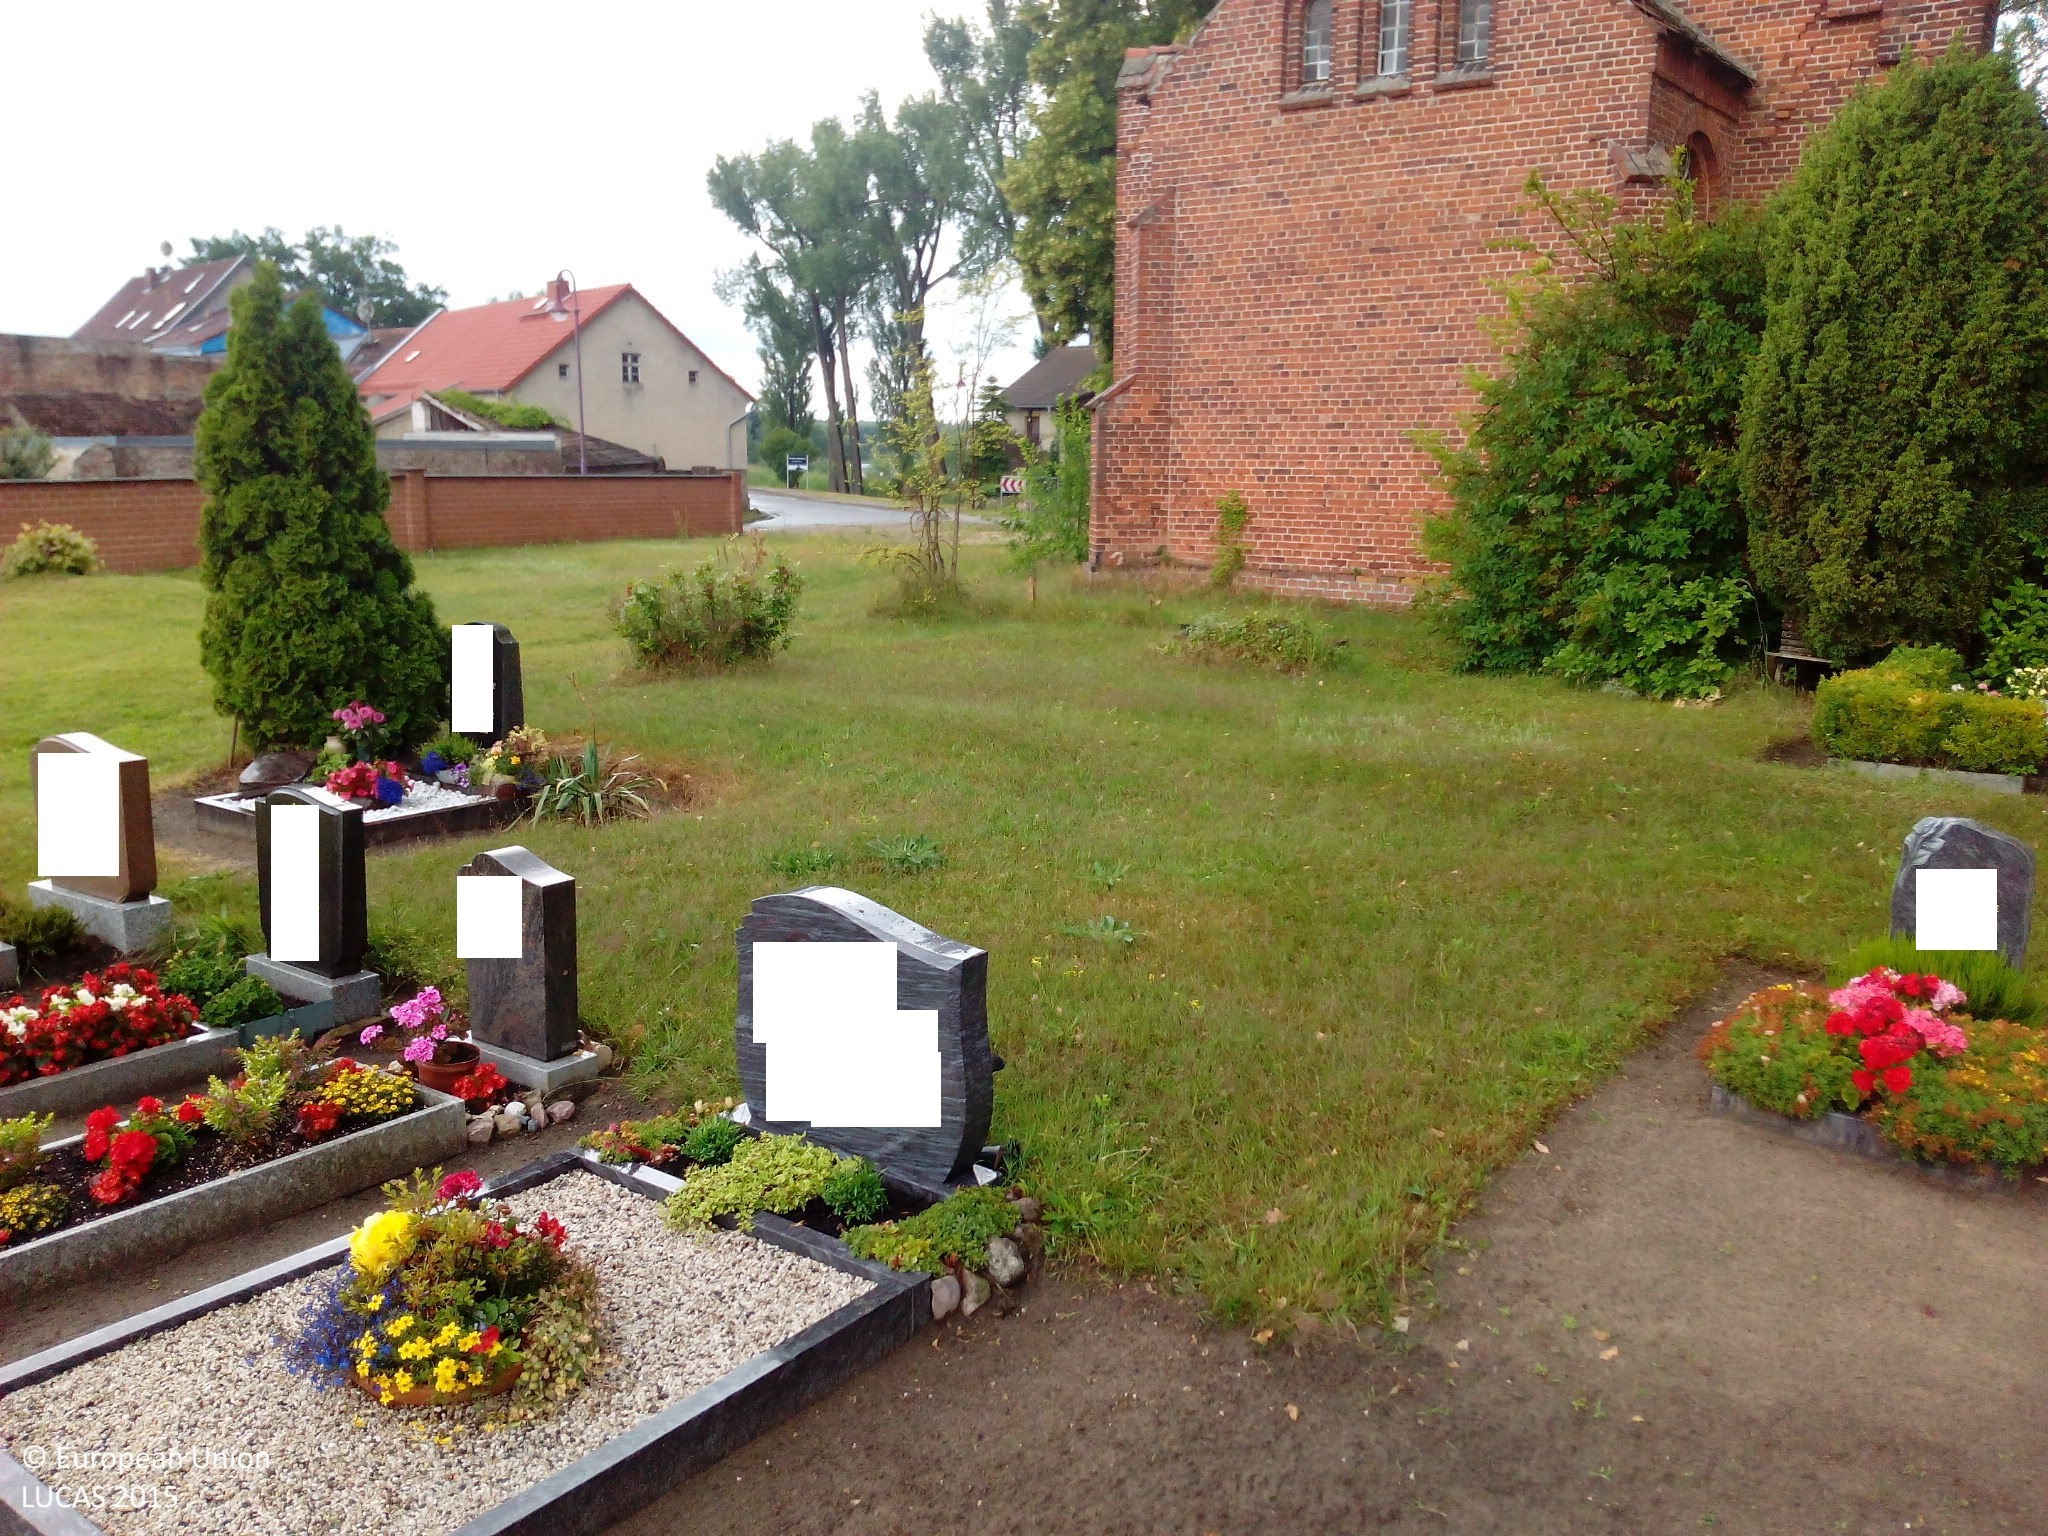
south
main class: Grassland
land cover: Grassland without tree/shrub cover
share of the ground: > 75 %
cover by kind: herbaceous plants 100 %
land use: Community services
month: June
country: DE
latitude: 52.4426
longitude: 12.4270
